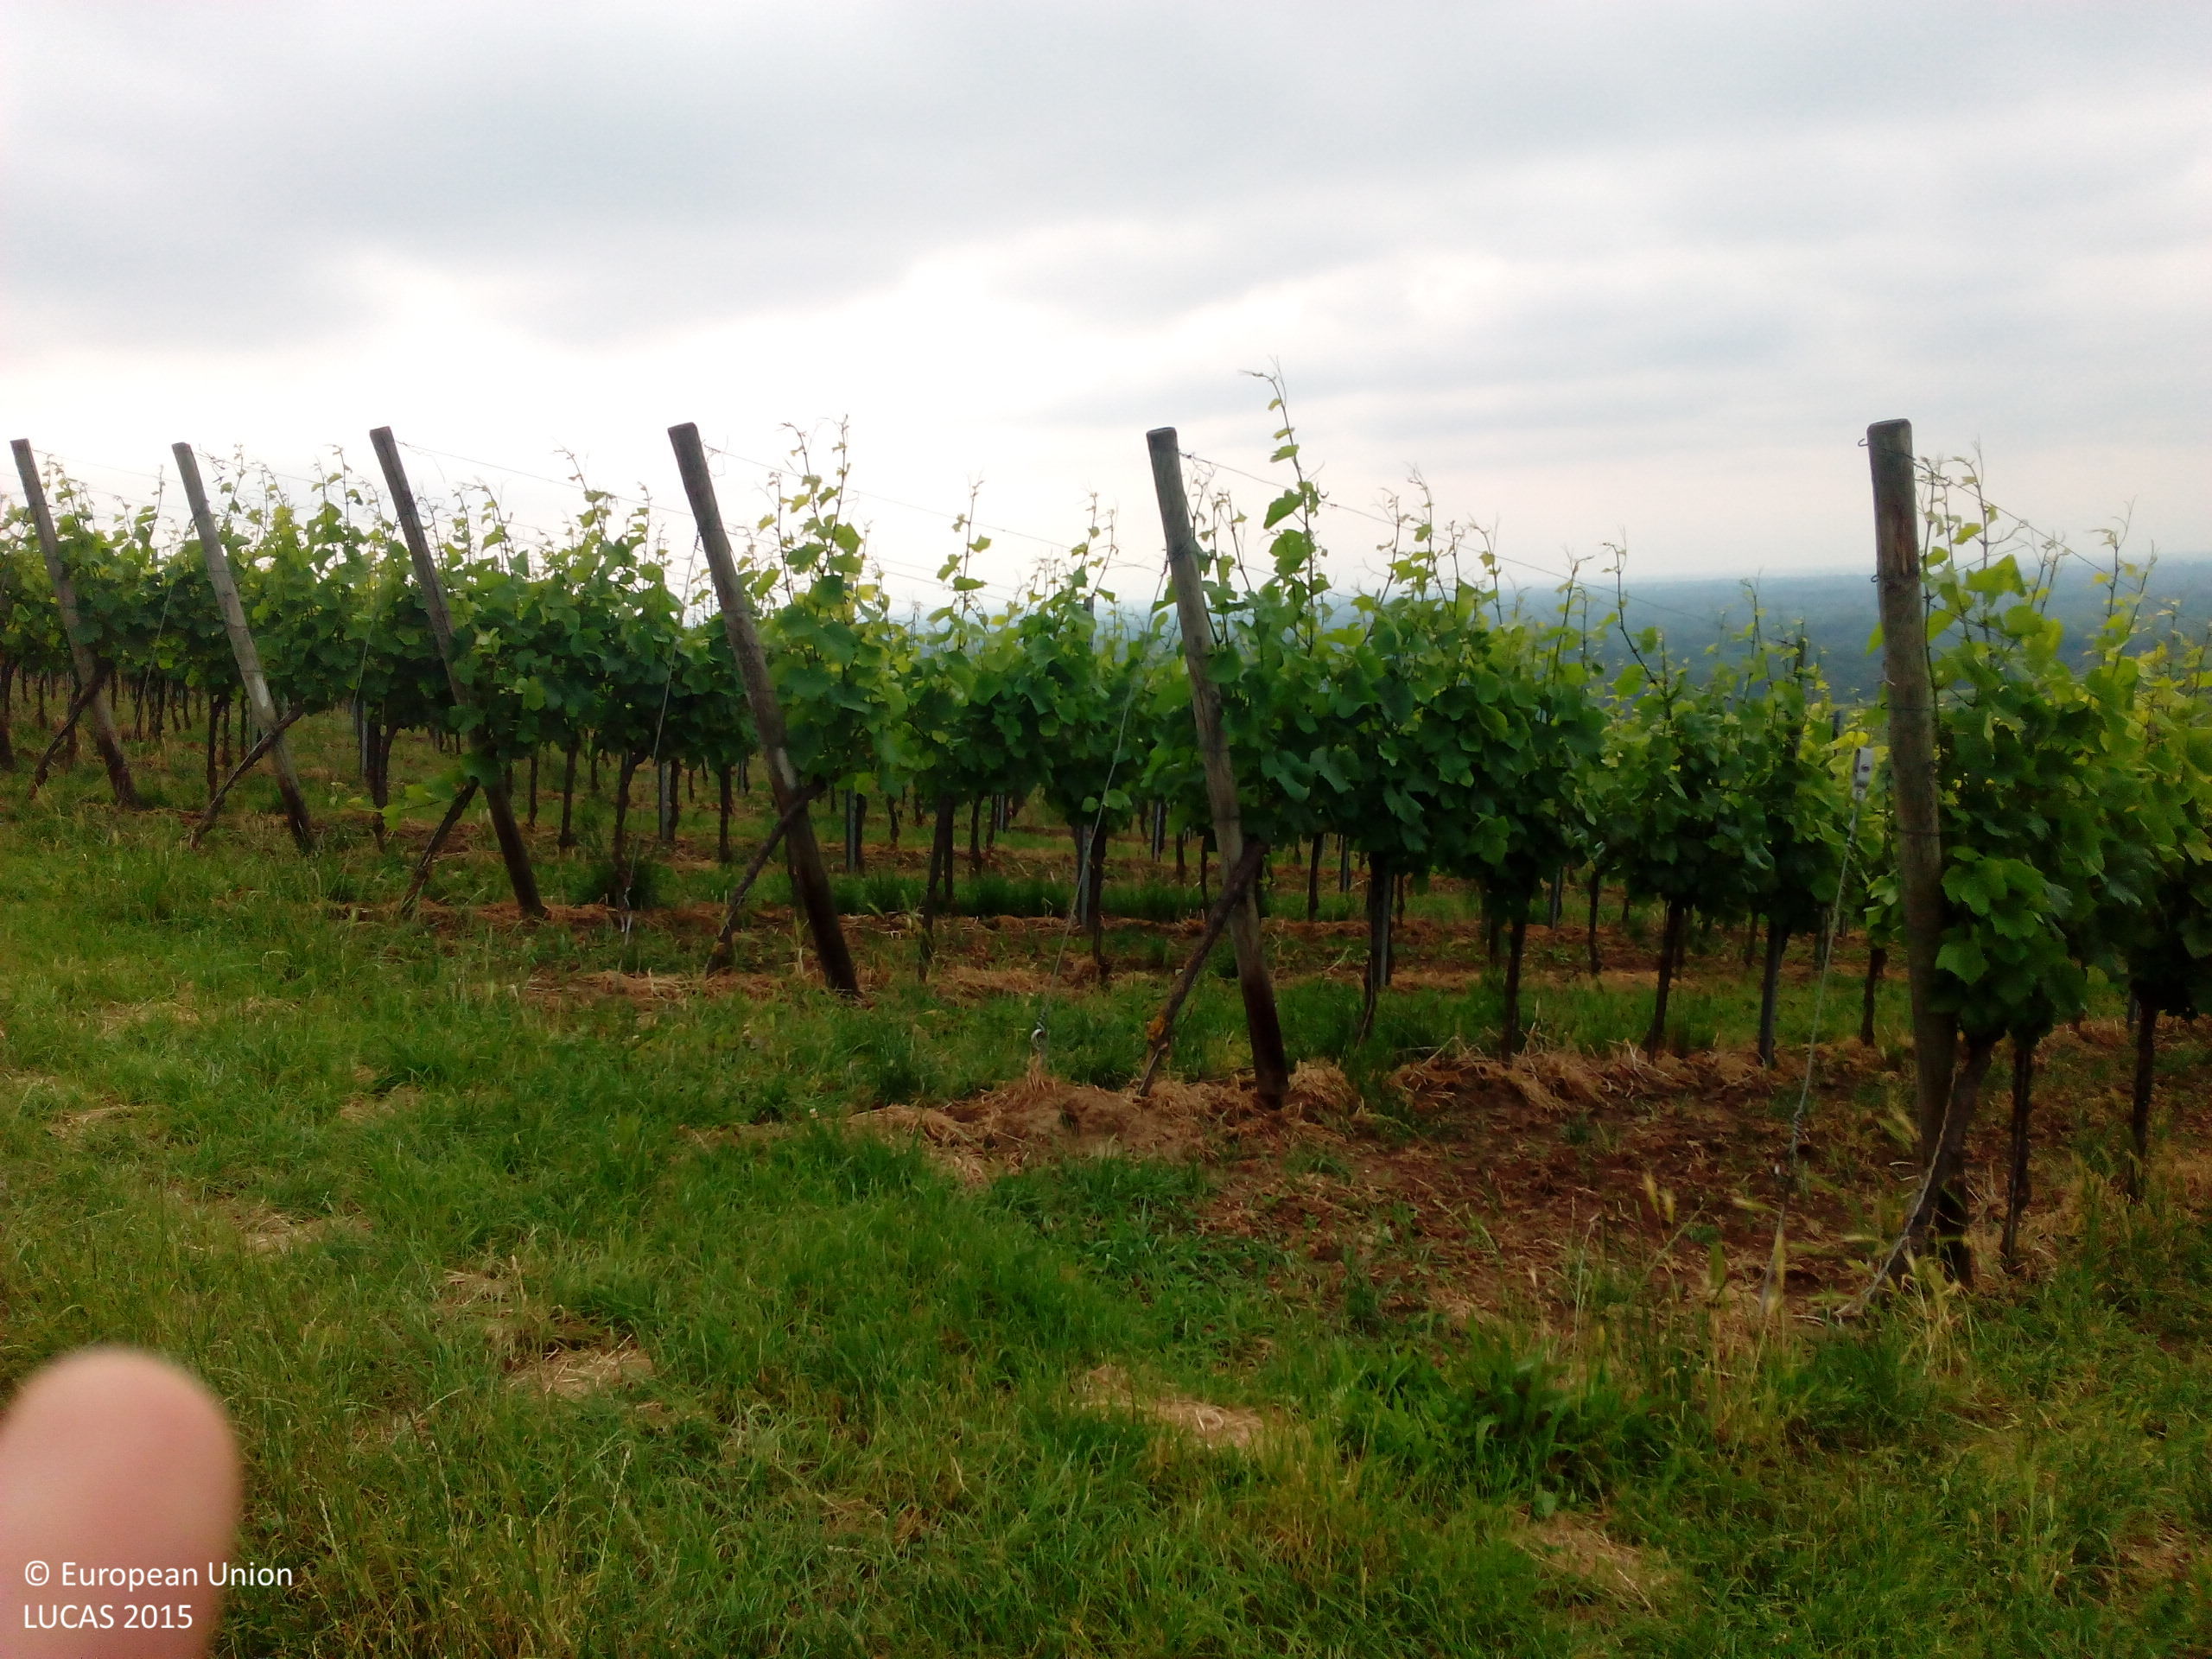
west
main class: Cropland
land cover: Vineyards
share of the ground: 25 - 50 %
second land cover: Grassland without tree/shrub cover
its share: 50 - 75 %
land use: Agriculture (excluding fallow land and kitchen gardens)
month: June
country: DE
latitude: 48.1259
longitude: 7.6231
